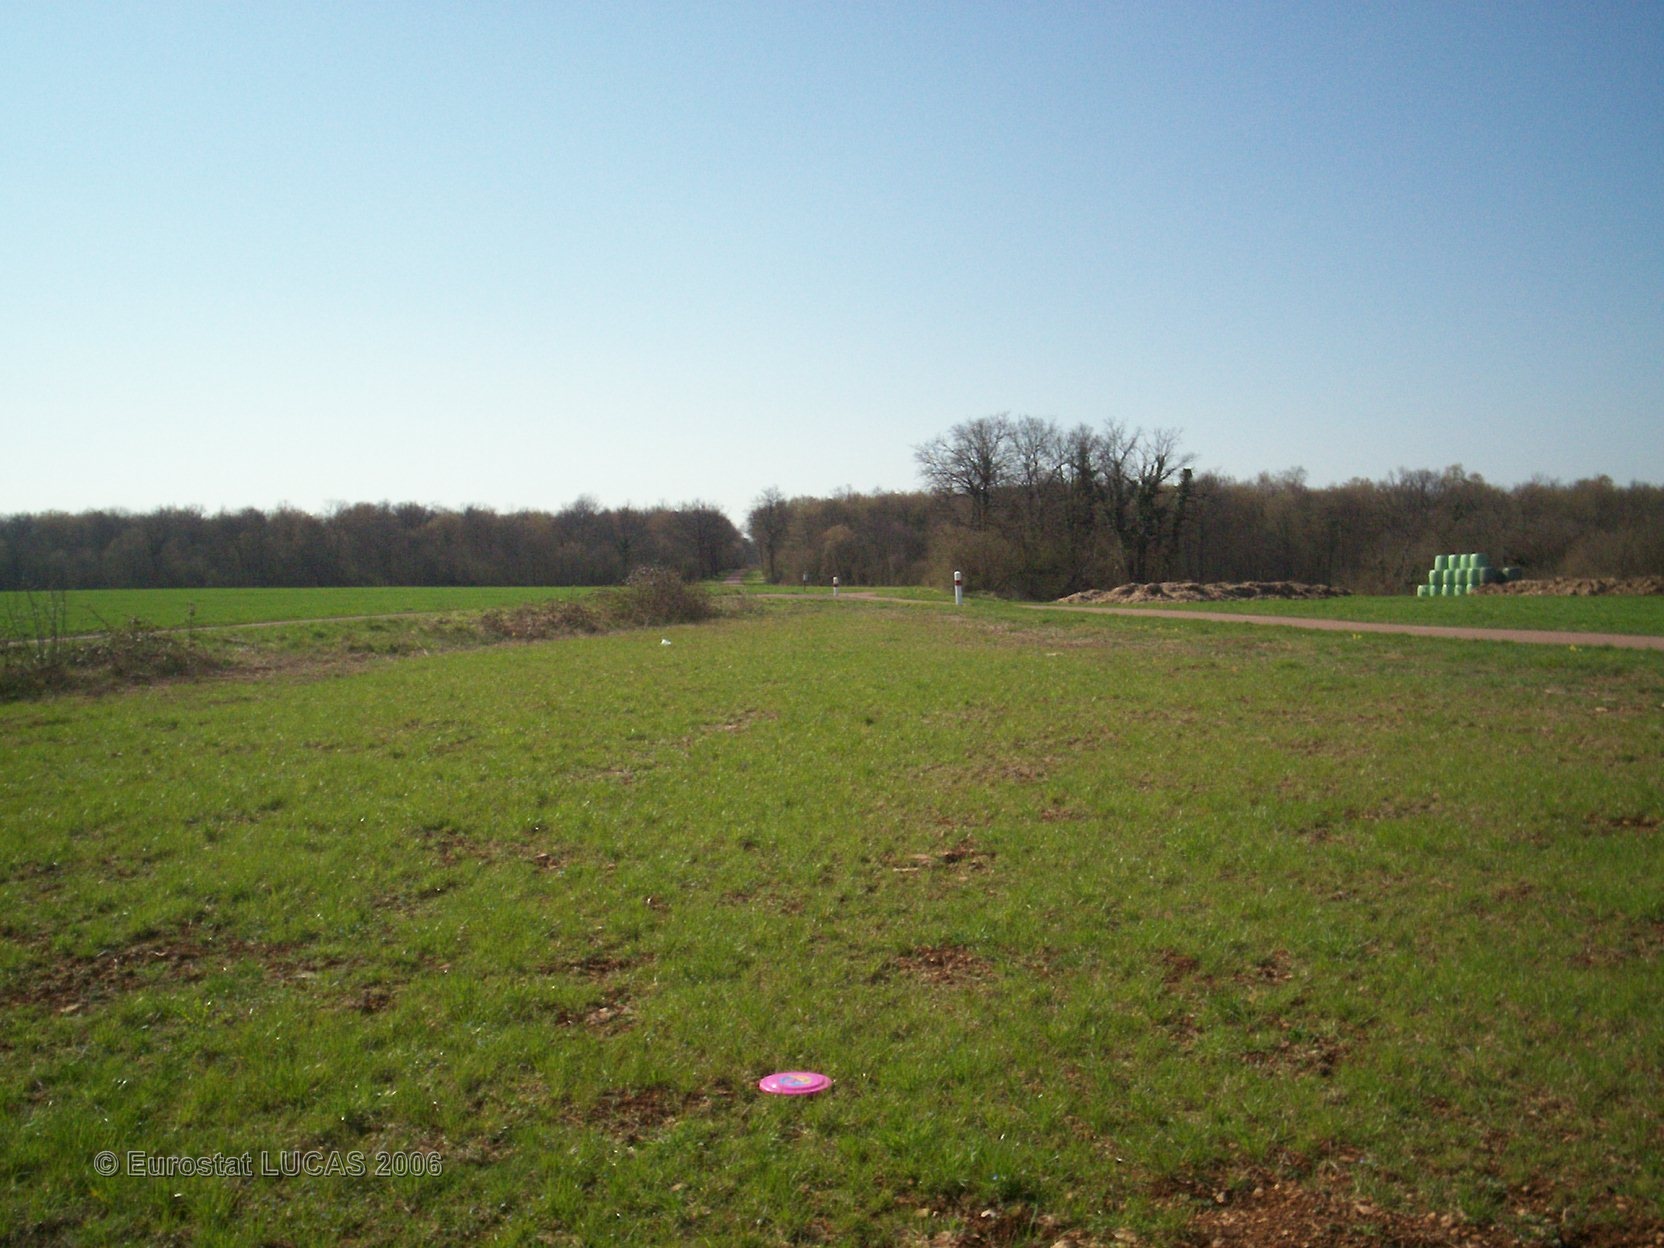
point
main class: Grassland
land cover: Grassland without tree/shrub cover
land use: Fallow land
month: April
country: FR
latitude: 47.4228
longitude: 4.5778
